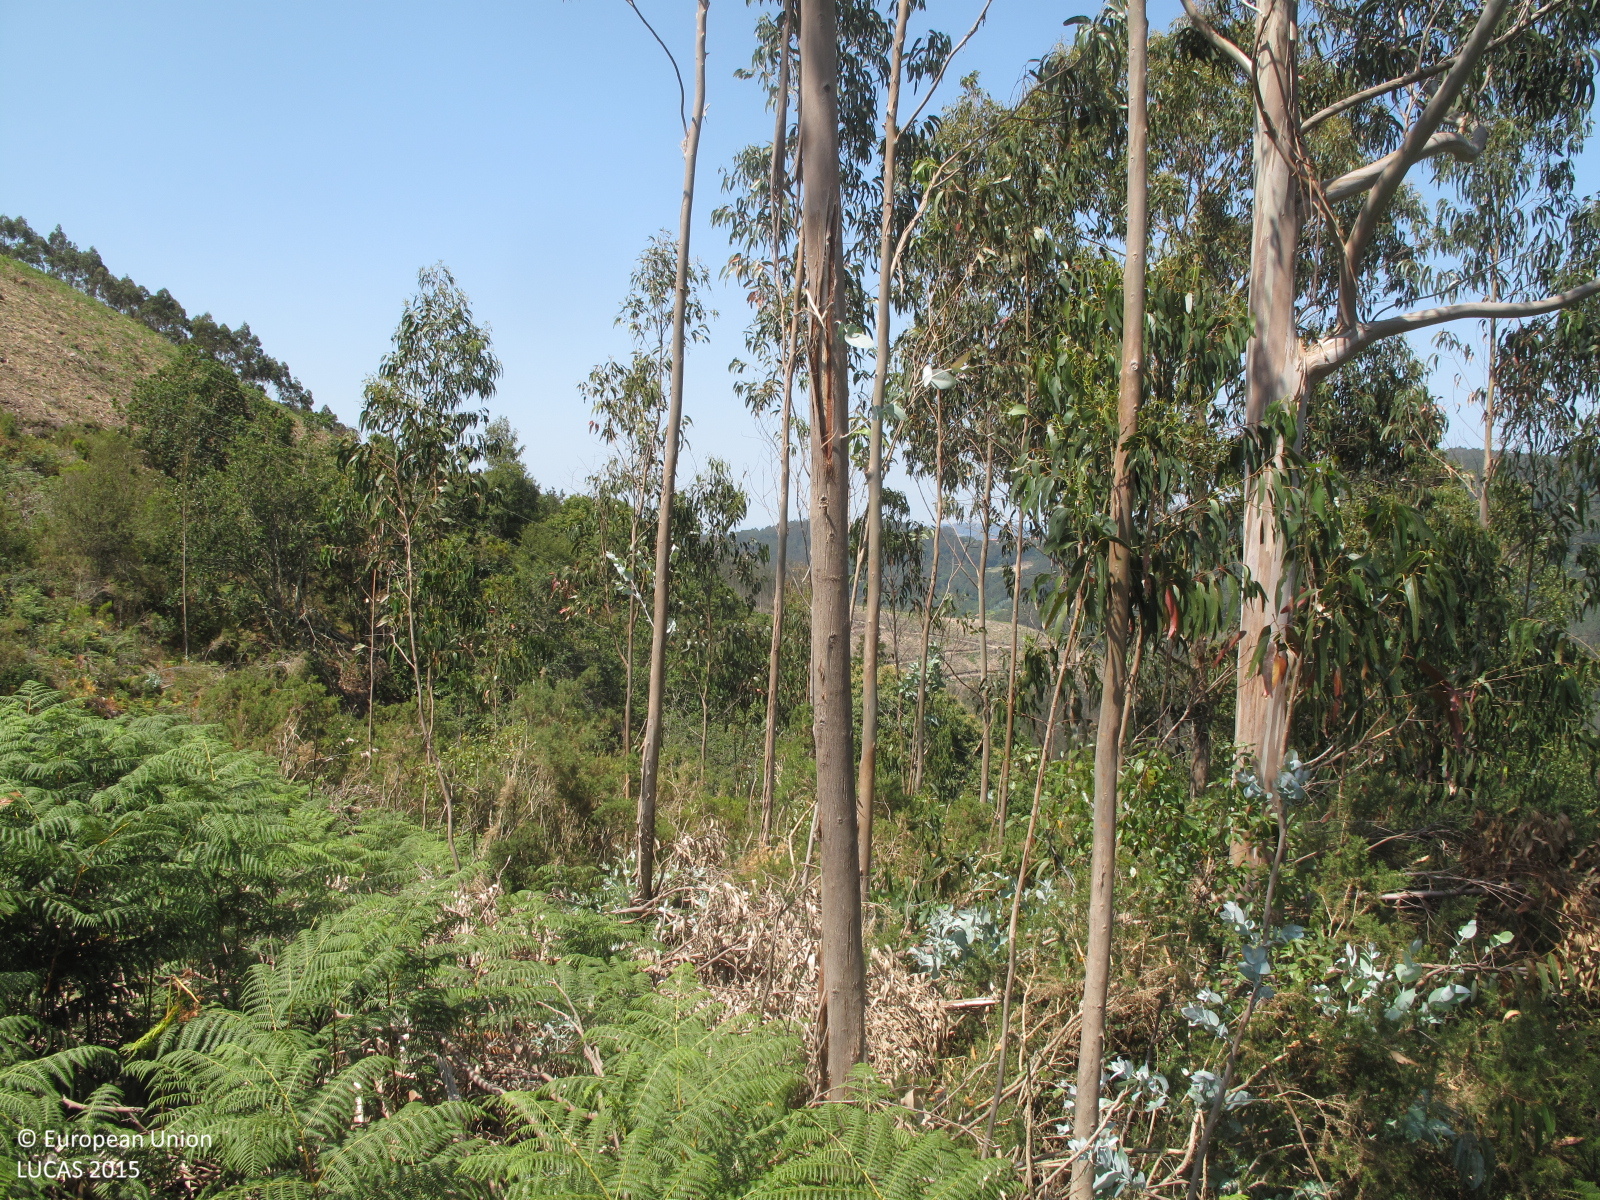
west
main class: Woodland
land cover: Broadleaved woodland
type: exotic forest
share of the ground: 25 - 50 %
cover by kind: shrubs 60 %, broadleaved forest trees 30 %, herbaceous plants 10 %
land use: Forestry
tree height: > 5 m
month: July
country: ES
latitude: 43.4216
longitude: -8.1196
